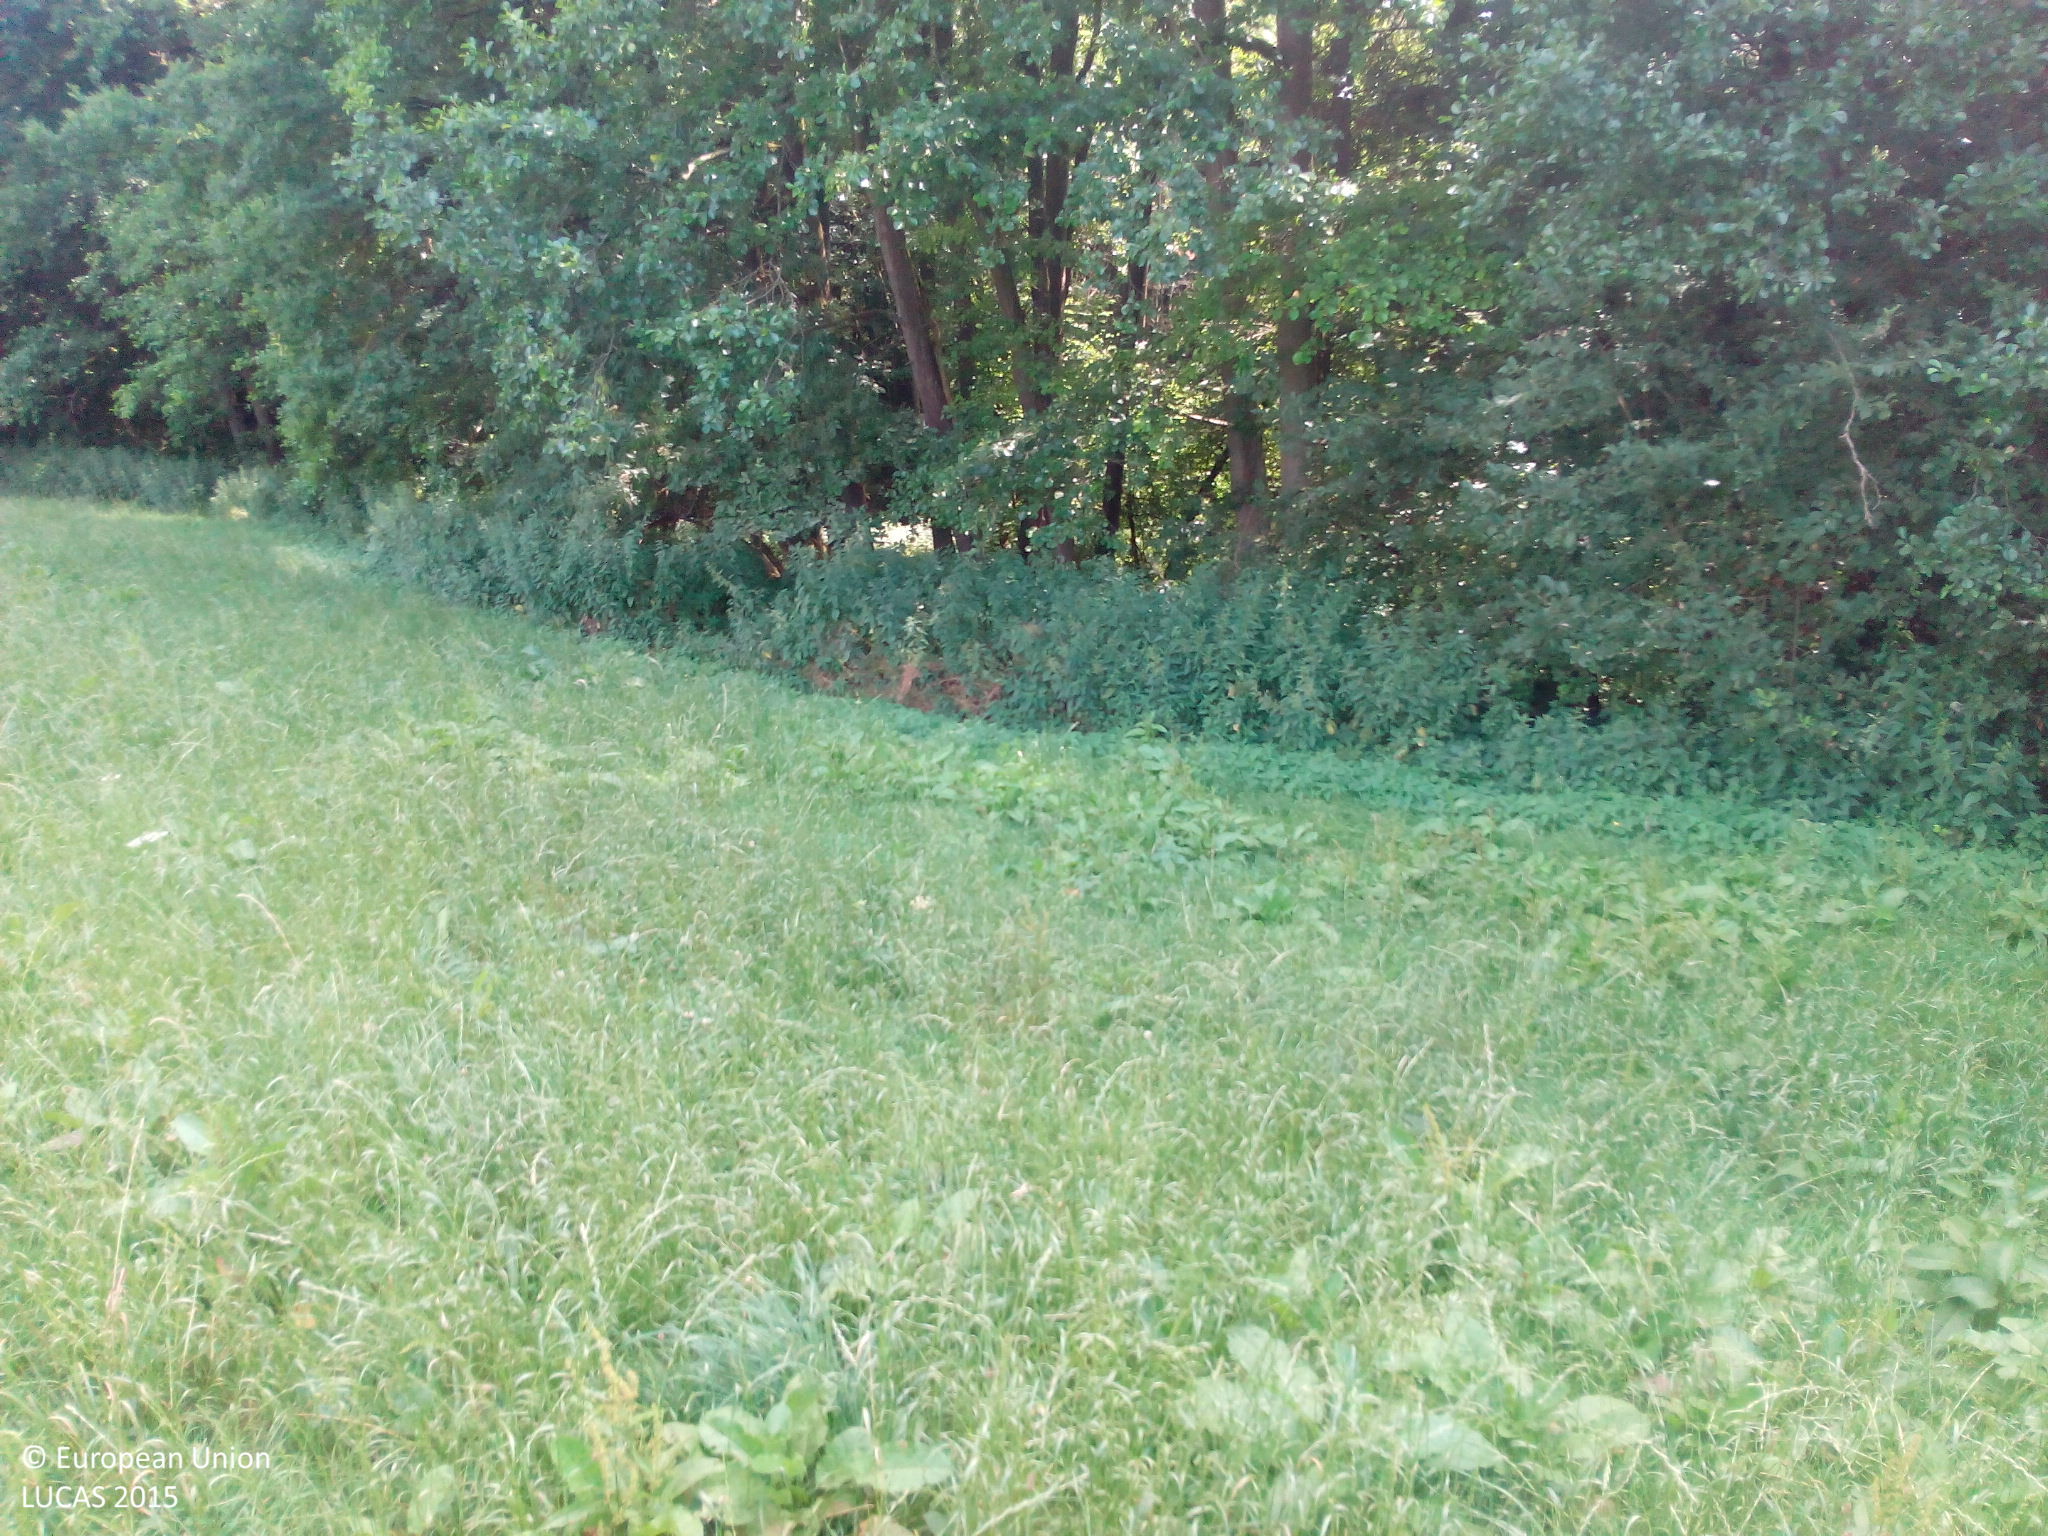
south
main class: Grassland
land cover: Grassland without tree/shrub cover
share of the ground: > 75 %
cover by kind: herbaceous plants 100 %
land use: Agriculture (excluding fallow land and kitchen gardens)
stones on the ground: < 10 %
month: July
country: DE
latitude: 49.4433
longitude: 10.8962
